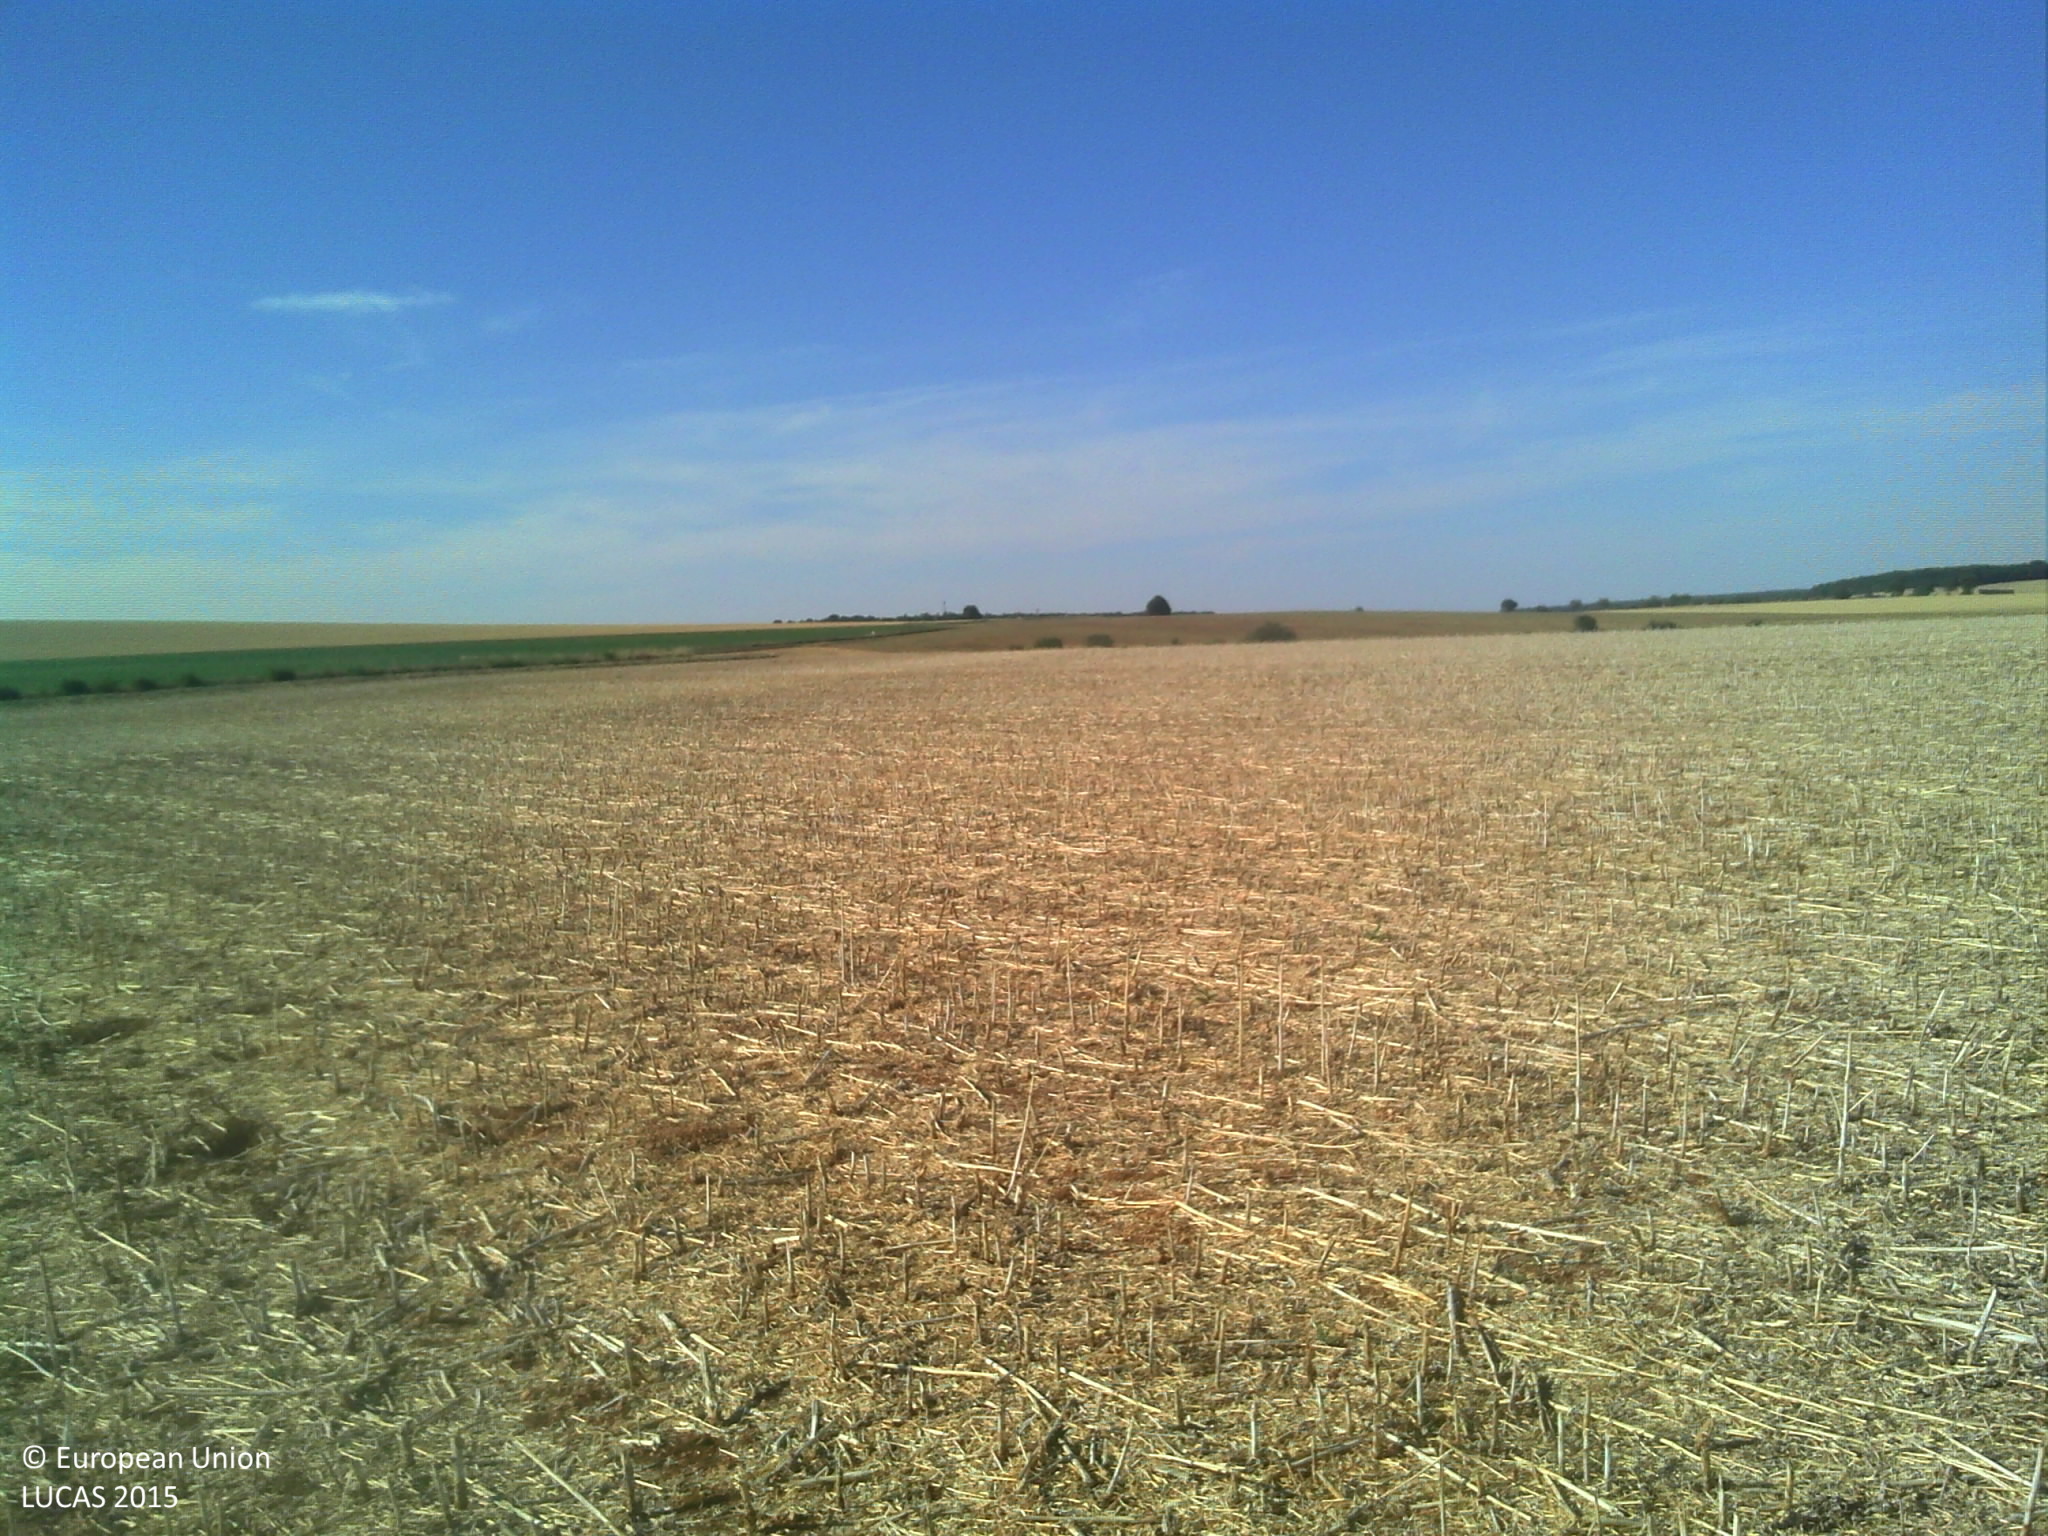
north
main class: Cropland
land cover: Rape and turnip rape
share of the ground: 10 - 25 %
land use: Agriculture (excluding fallow land and kitchen gardens)
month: August
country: FR
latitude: 47.6944
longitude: 4.9764
